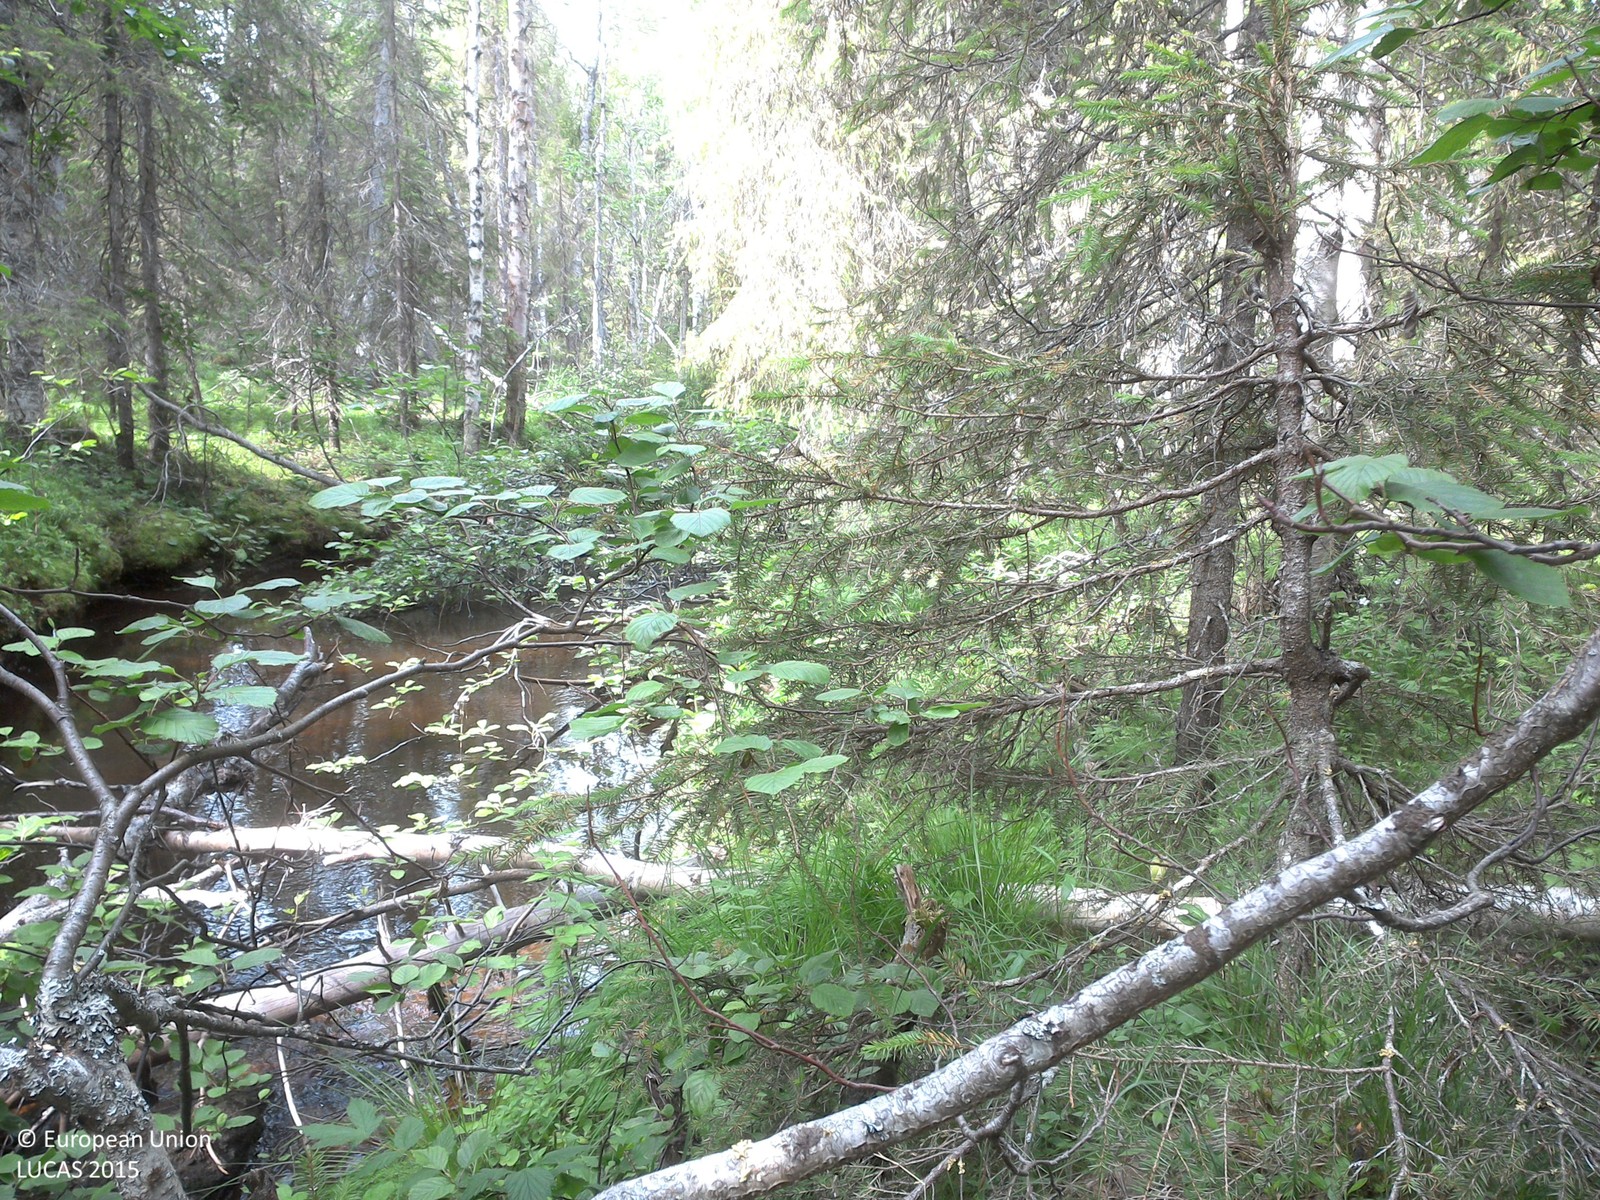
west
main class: Woodland
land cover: Spruce dominated mixed woodland
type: boreal forest
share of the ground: 50 - 75 %
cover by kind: shrubs 40 %, coniferous forest trees 30 %, broadleaved forest trees 15 %, herbaceous plants 15 %
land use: Forestry
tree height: > 5 m
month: July
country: SE
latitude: 67.4917
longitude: 23.3807
